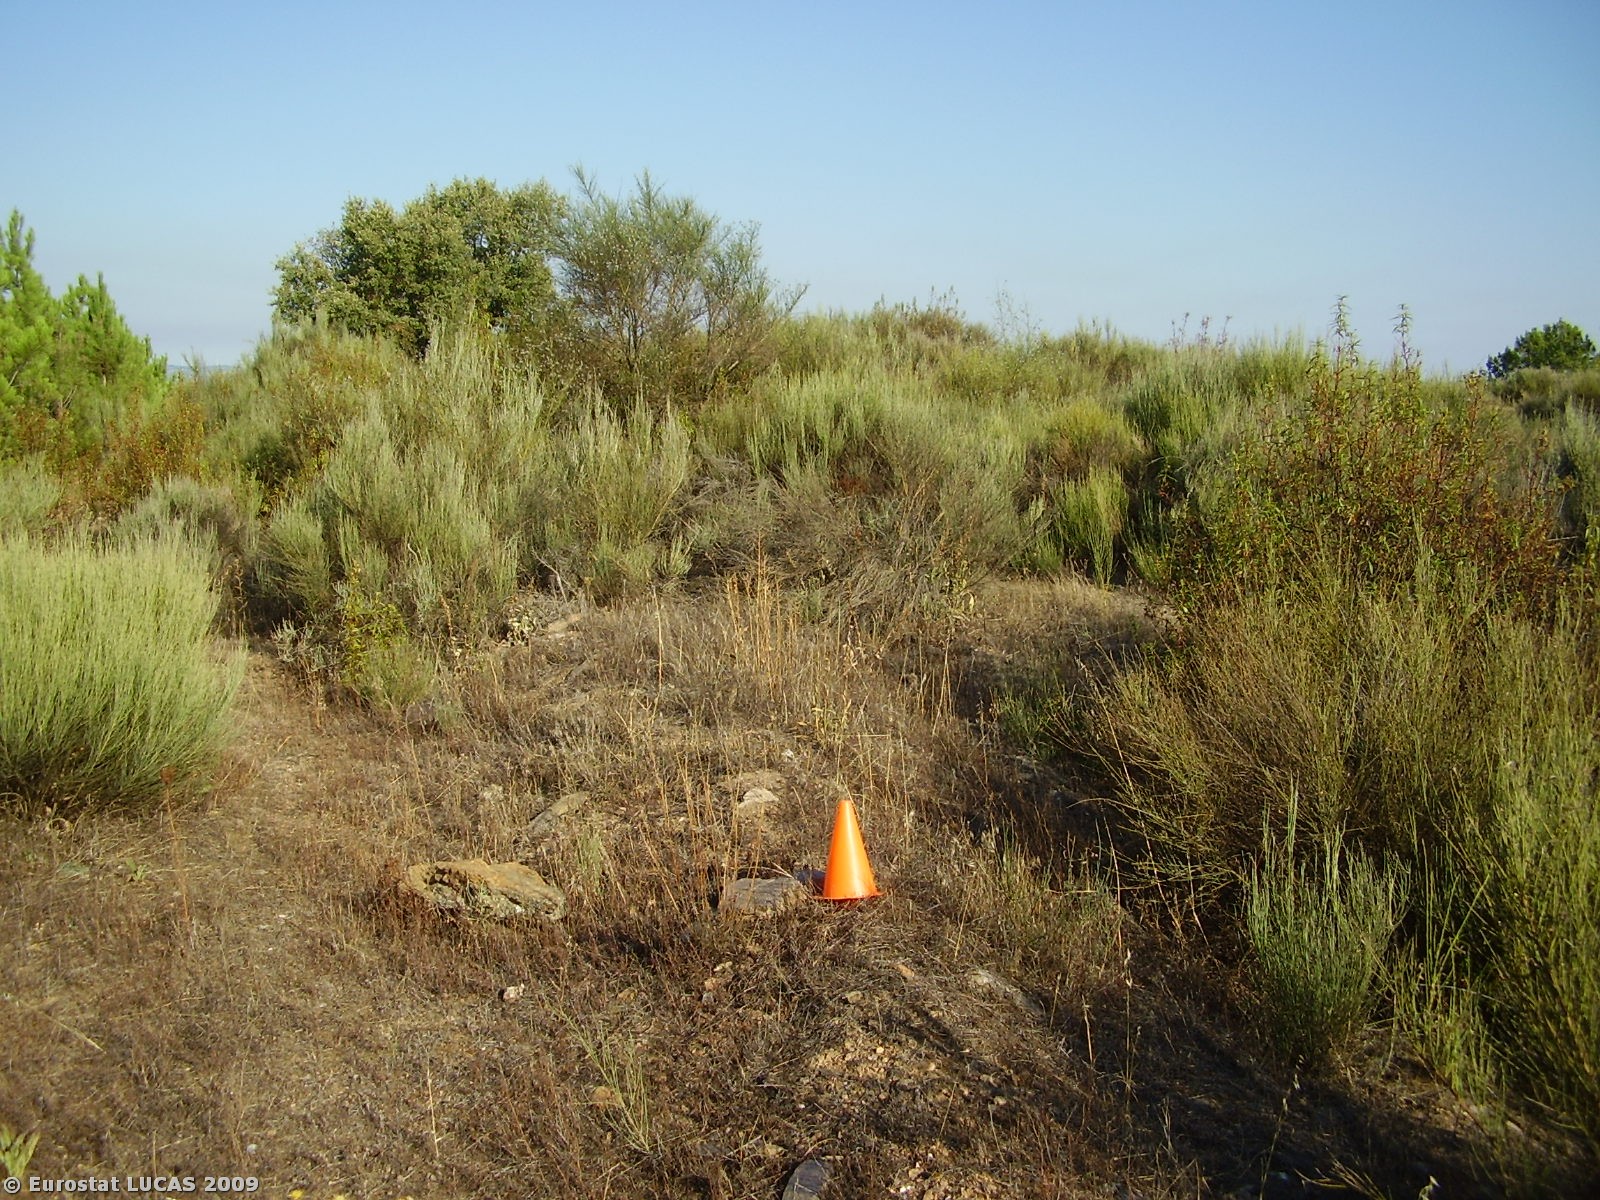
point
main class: Shrubland
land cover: Shrubland with sparse tree cover
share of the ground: > 75 %
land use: Fallow land
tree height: > 5 m
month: August
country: PT
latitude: 41.3567
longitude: -6.7573
